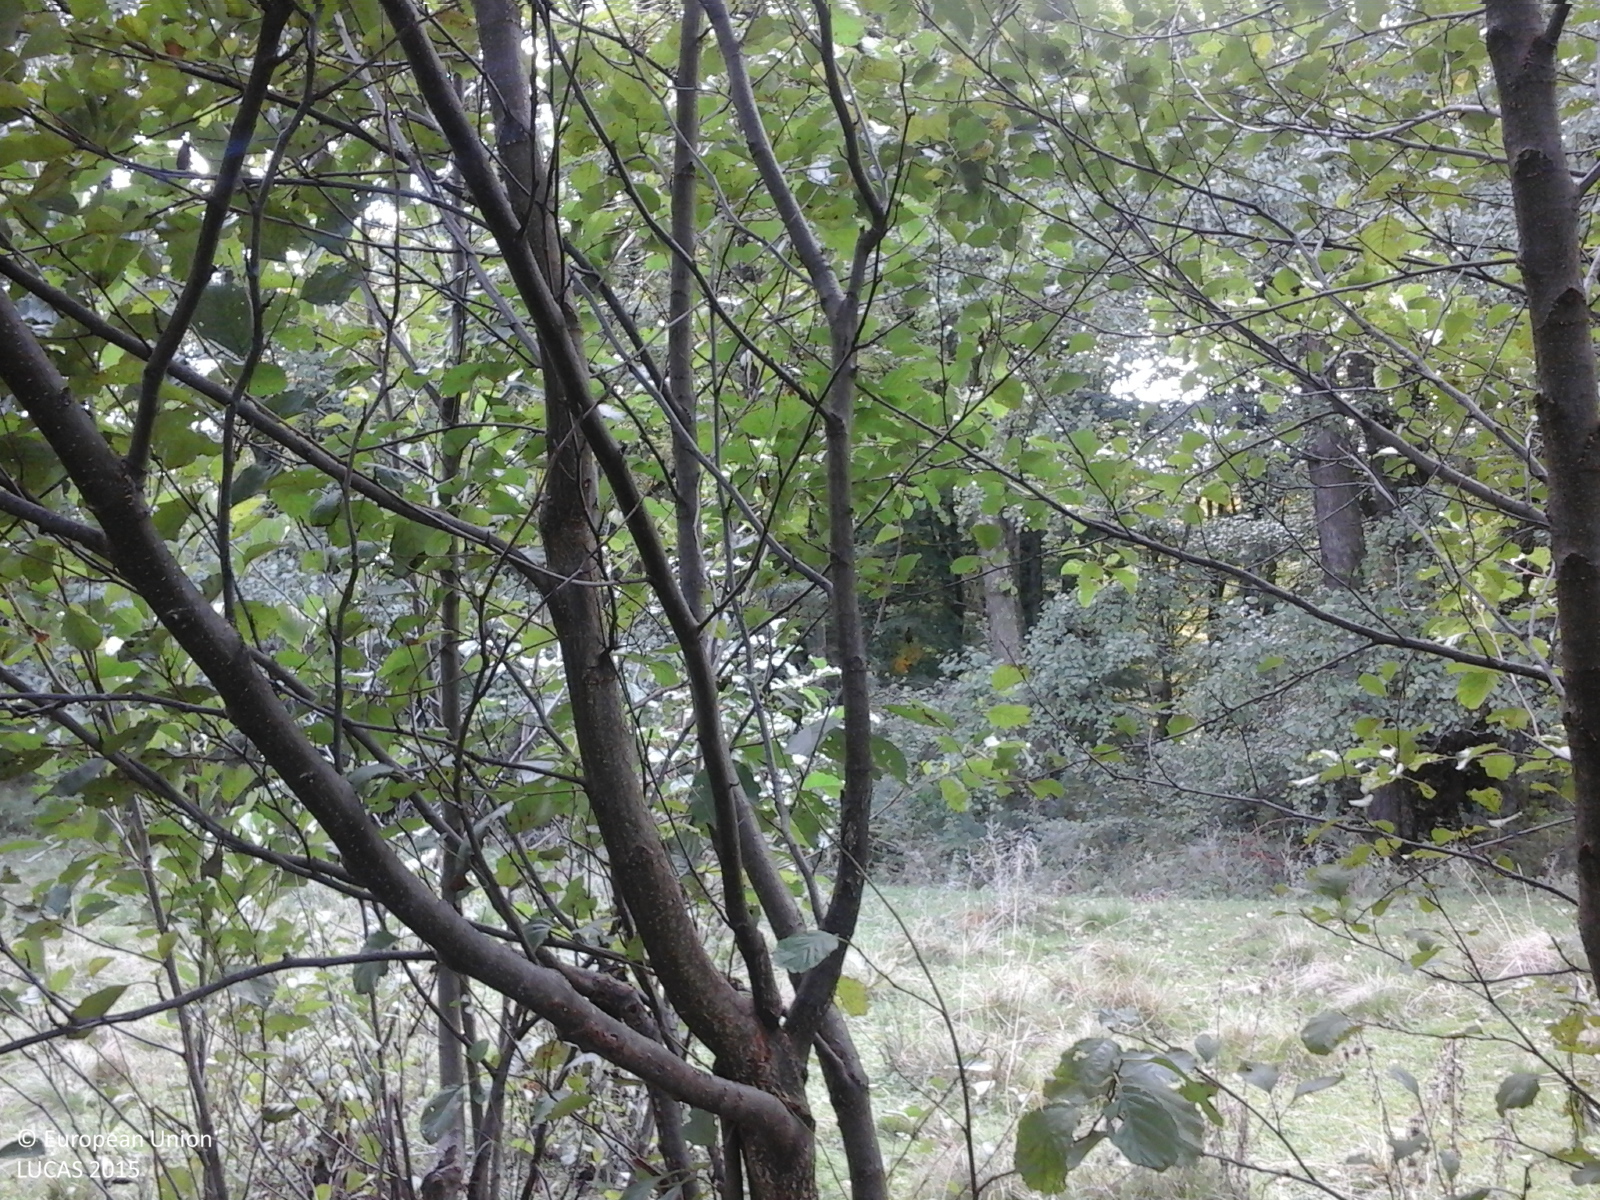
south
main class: Woodland
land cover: Broadleaved woodland
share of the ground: > 75 %
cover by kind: broadleaved forest trees 100 %
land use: Forestry
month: October
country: RO
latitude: 46.3046
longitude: 25.1741
